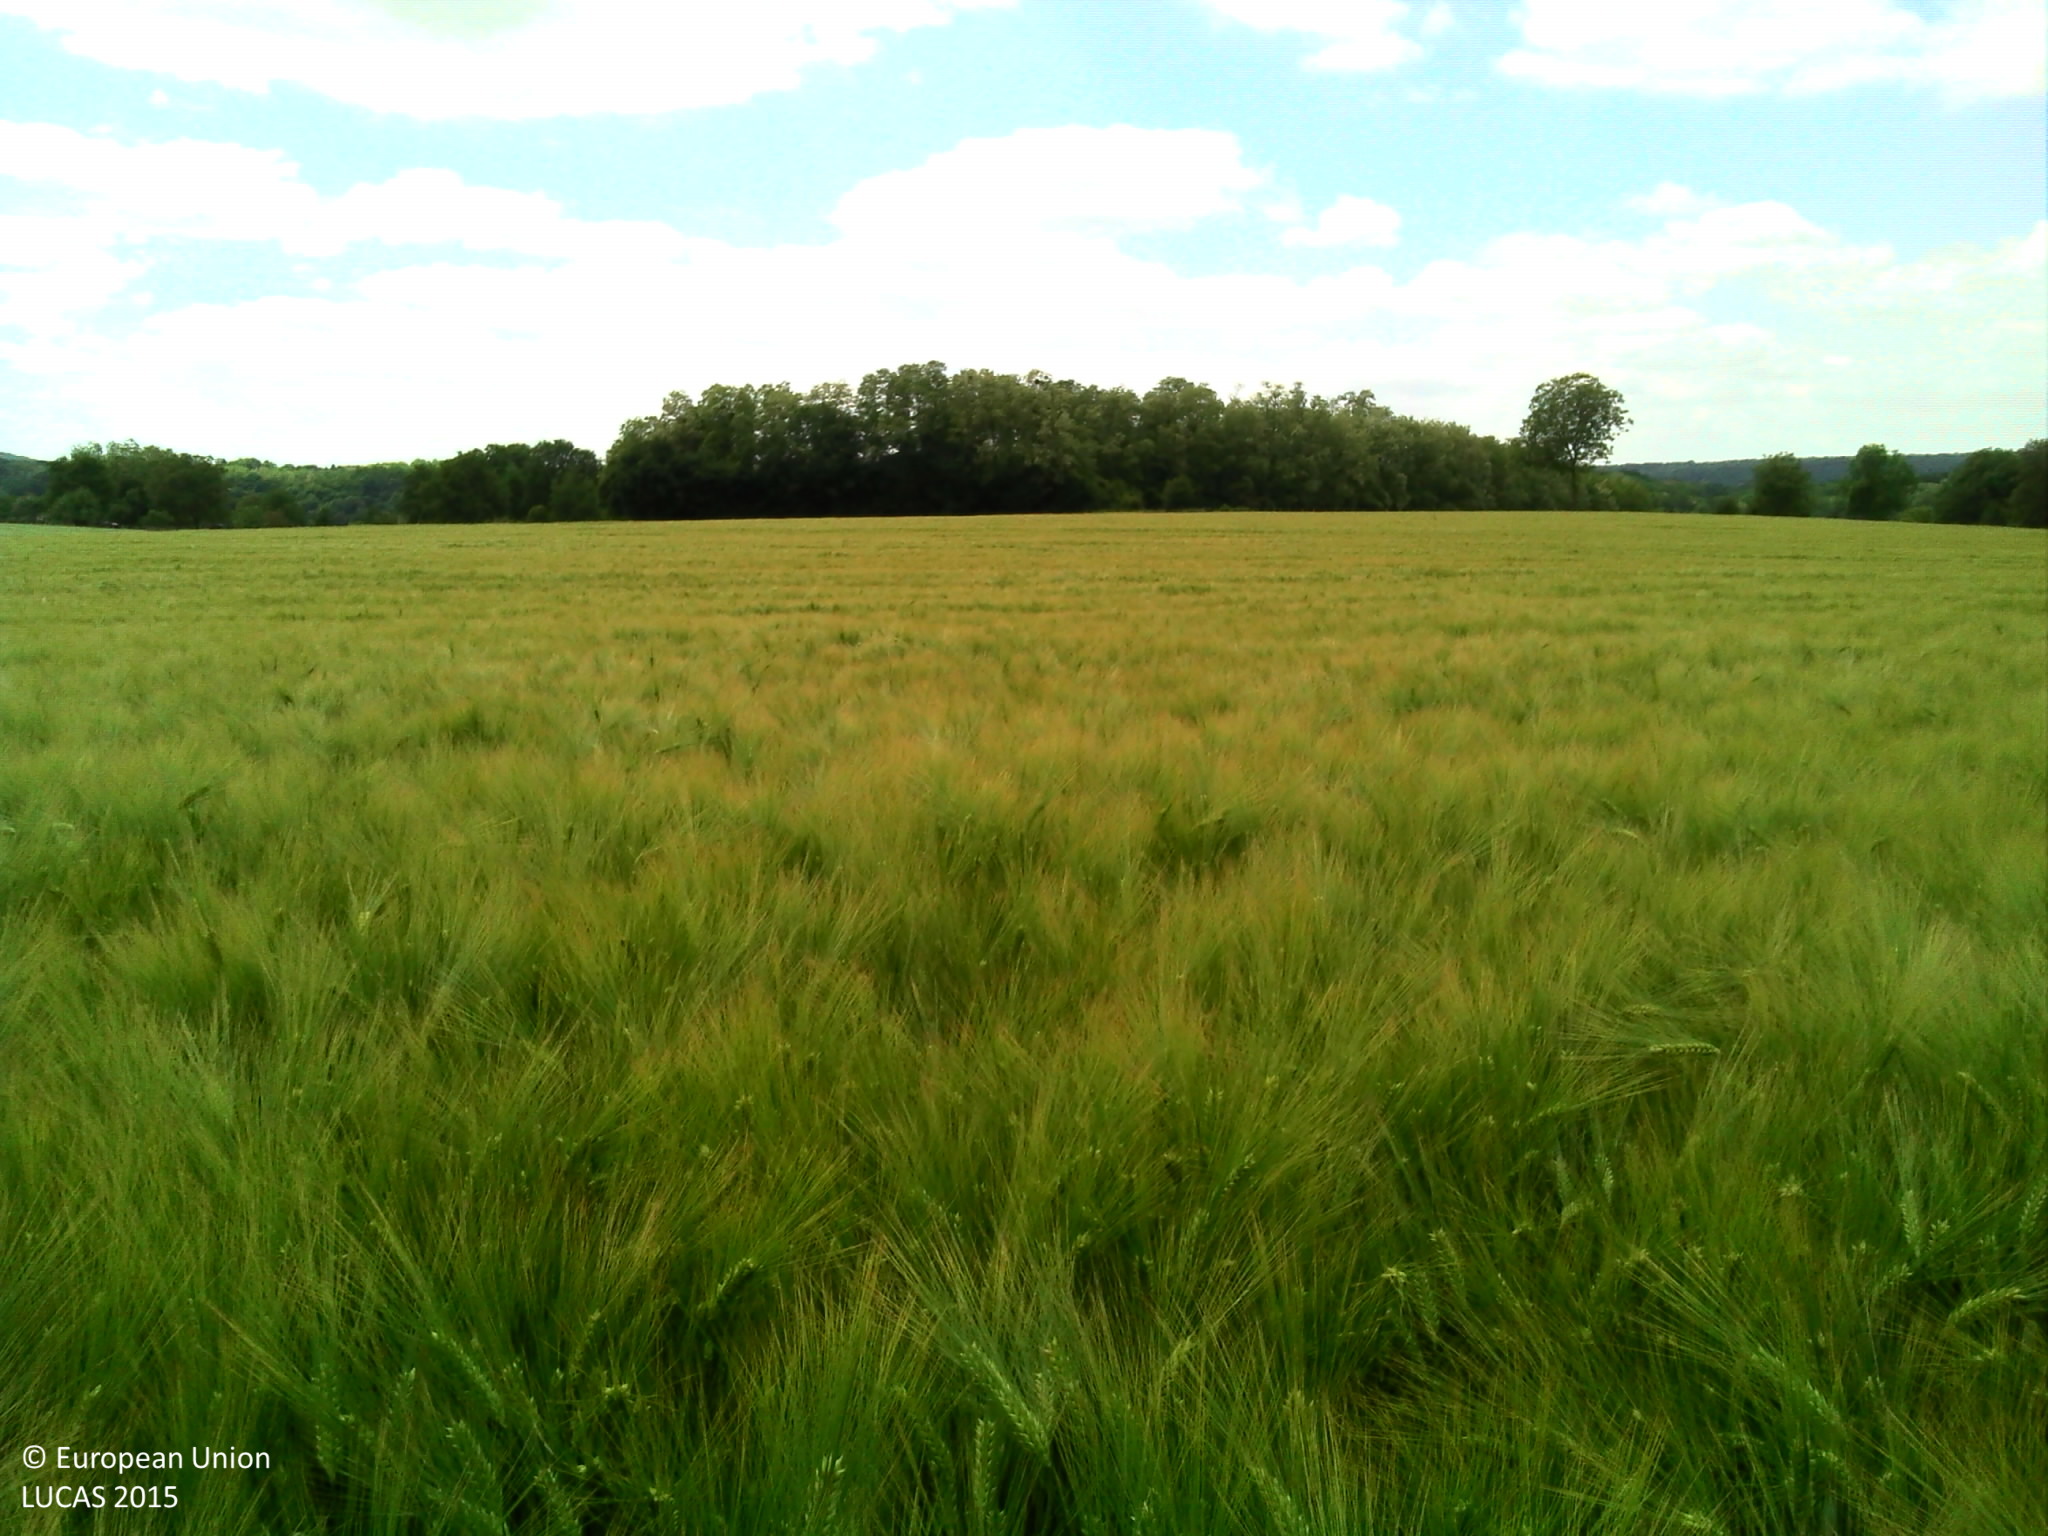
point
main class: Cropland
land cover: Common wheat
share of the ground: > 75 %
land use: Agriculture (excluding fallow land and kitchen gardens)
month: May
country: FR
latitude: 47.7201
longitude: 6.0418
